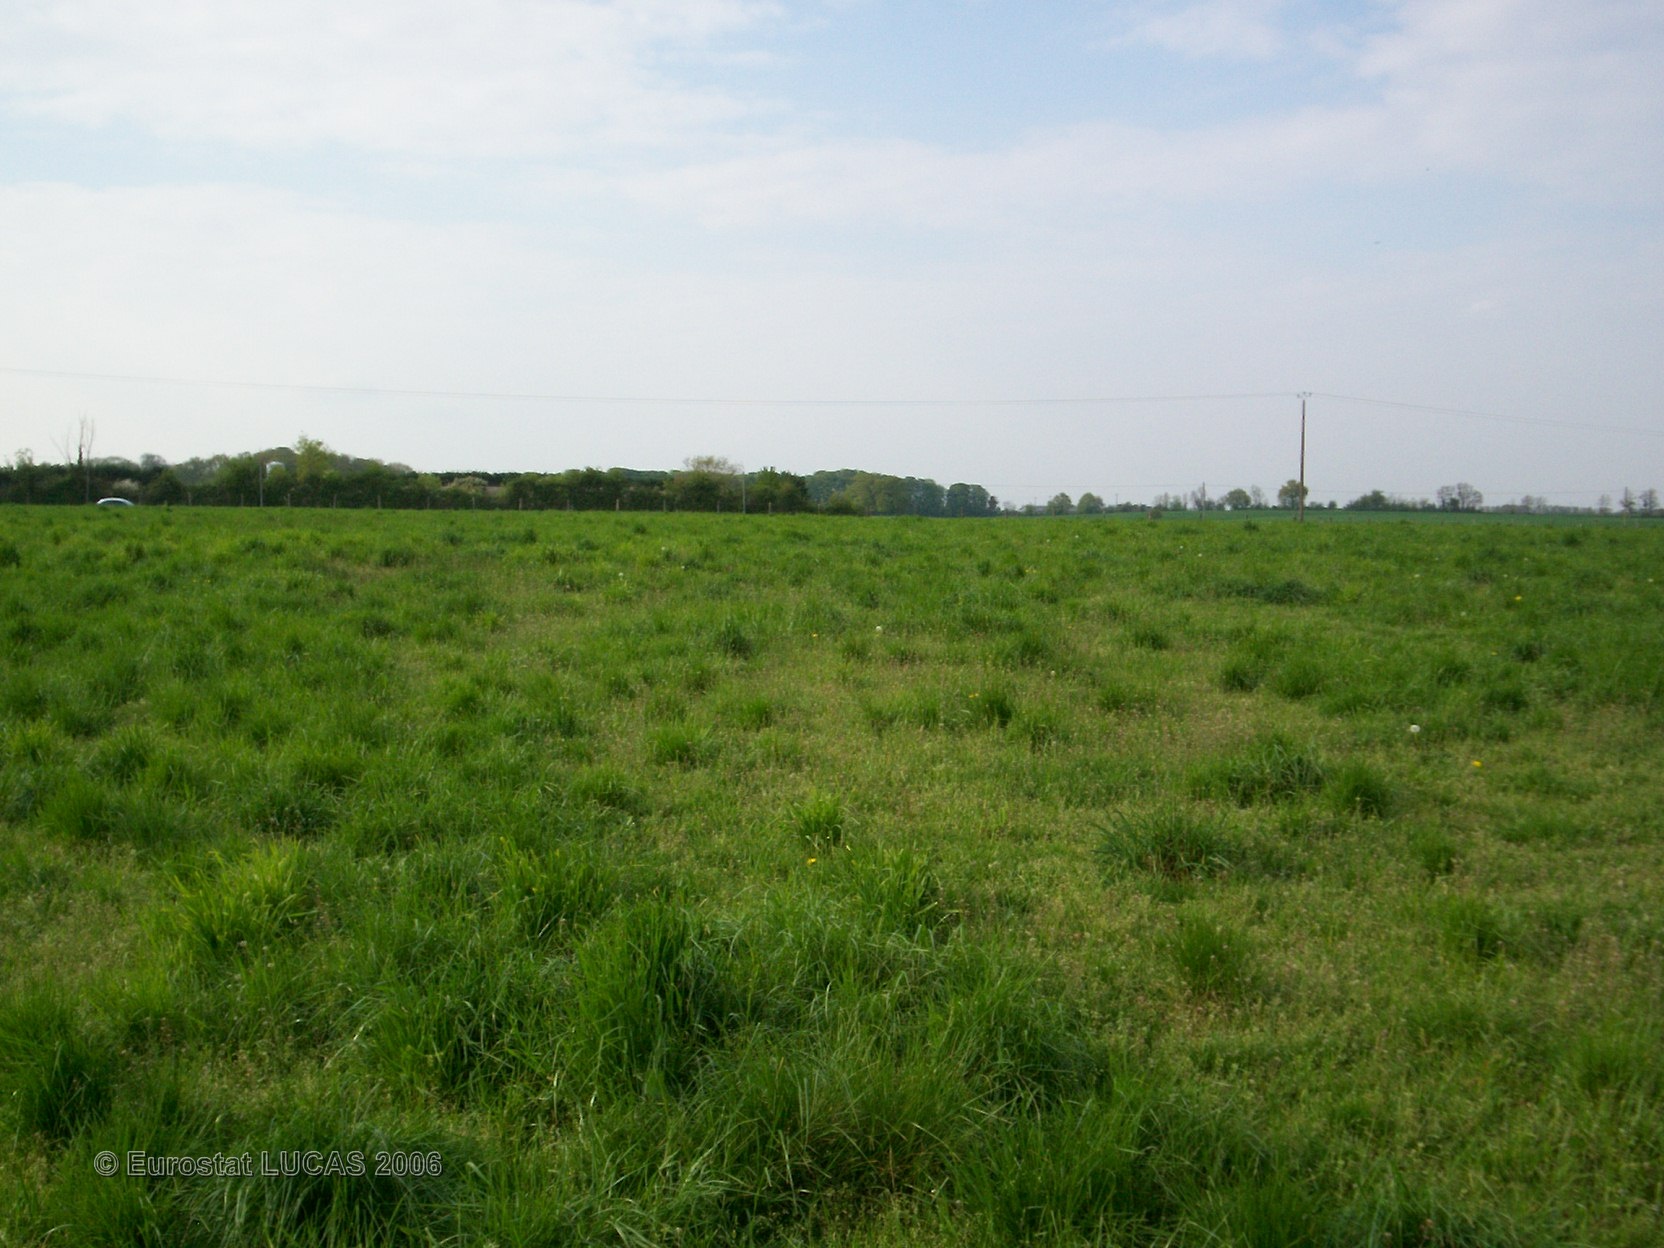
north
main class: Grassland
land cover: Grassland without tree/shrub cover
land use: Agriculture (excluding fallow land and kitchen gardens)
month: April
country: FR
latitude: 47.9138
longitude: -0.1852
